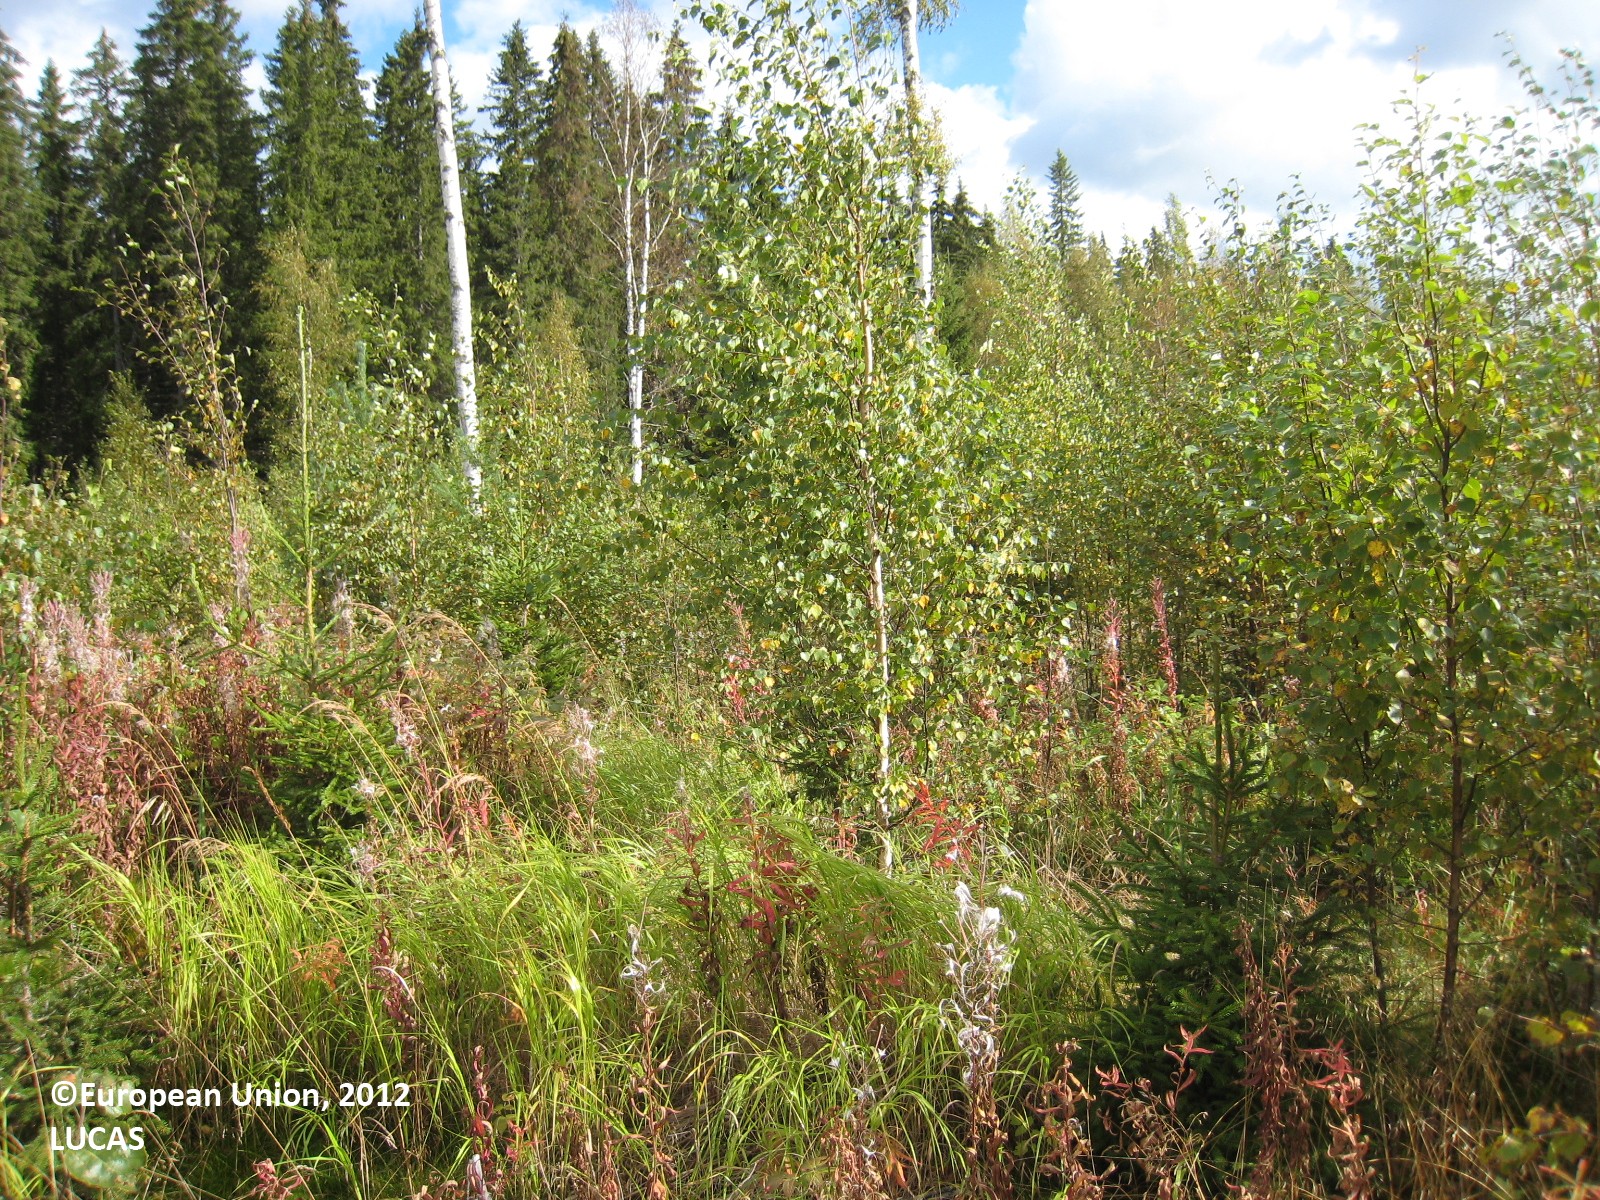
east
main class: Woodland
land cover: Other mixed woodland
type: boreal forest
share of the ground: 50 - 75 %
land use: Forestry
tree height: > 5 m
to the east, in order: Other mixed woodland; Spruce dominated mixed woodland; Ditches and canals; Spruce dominated mixed woodland; Spruce dominated coniferous woodland; Tracks; Spruce dominated coniferous woodland; Electric lines; Spruce dominated mixed woodland; Ditches and canals
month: September
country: FI
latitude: 63.0370
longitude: 26.7240
